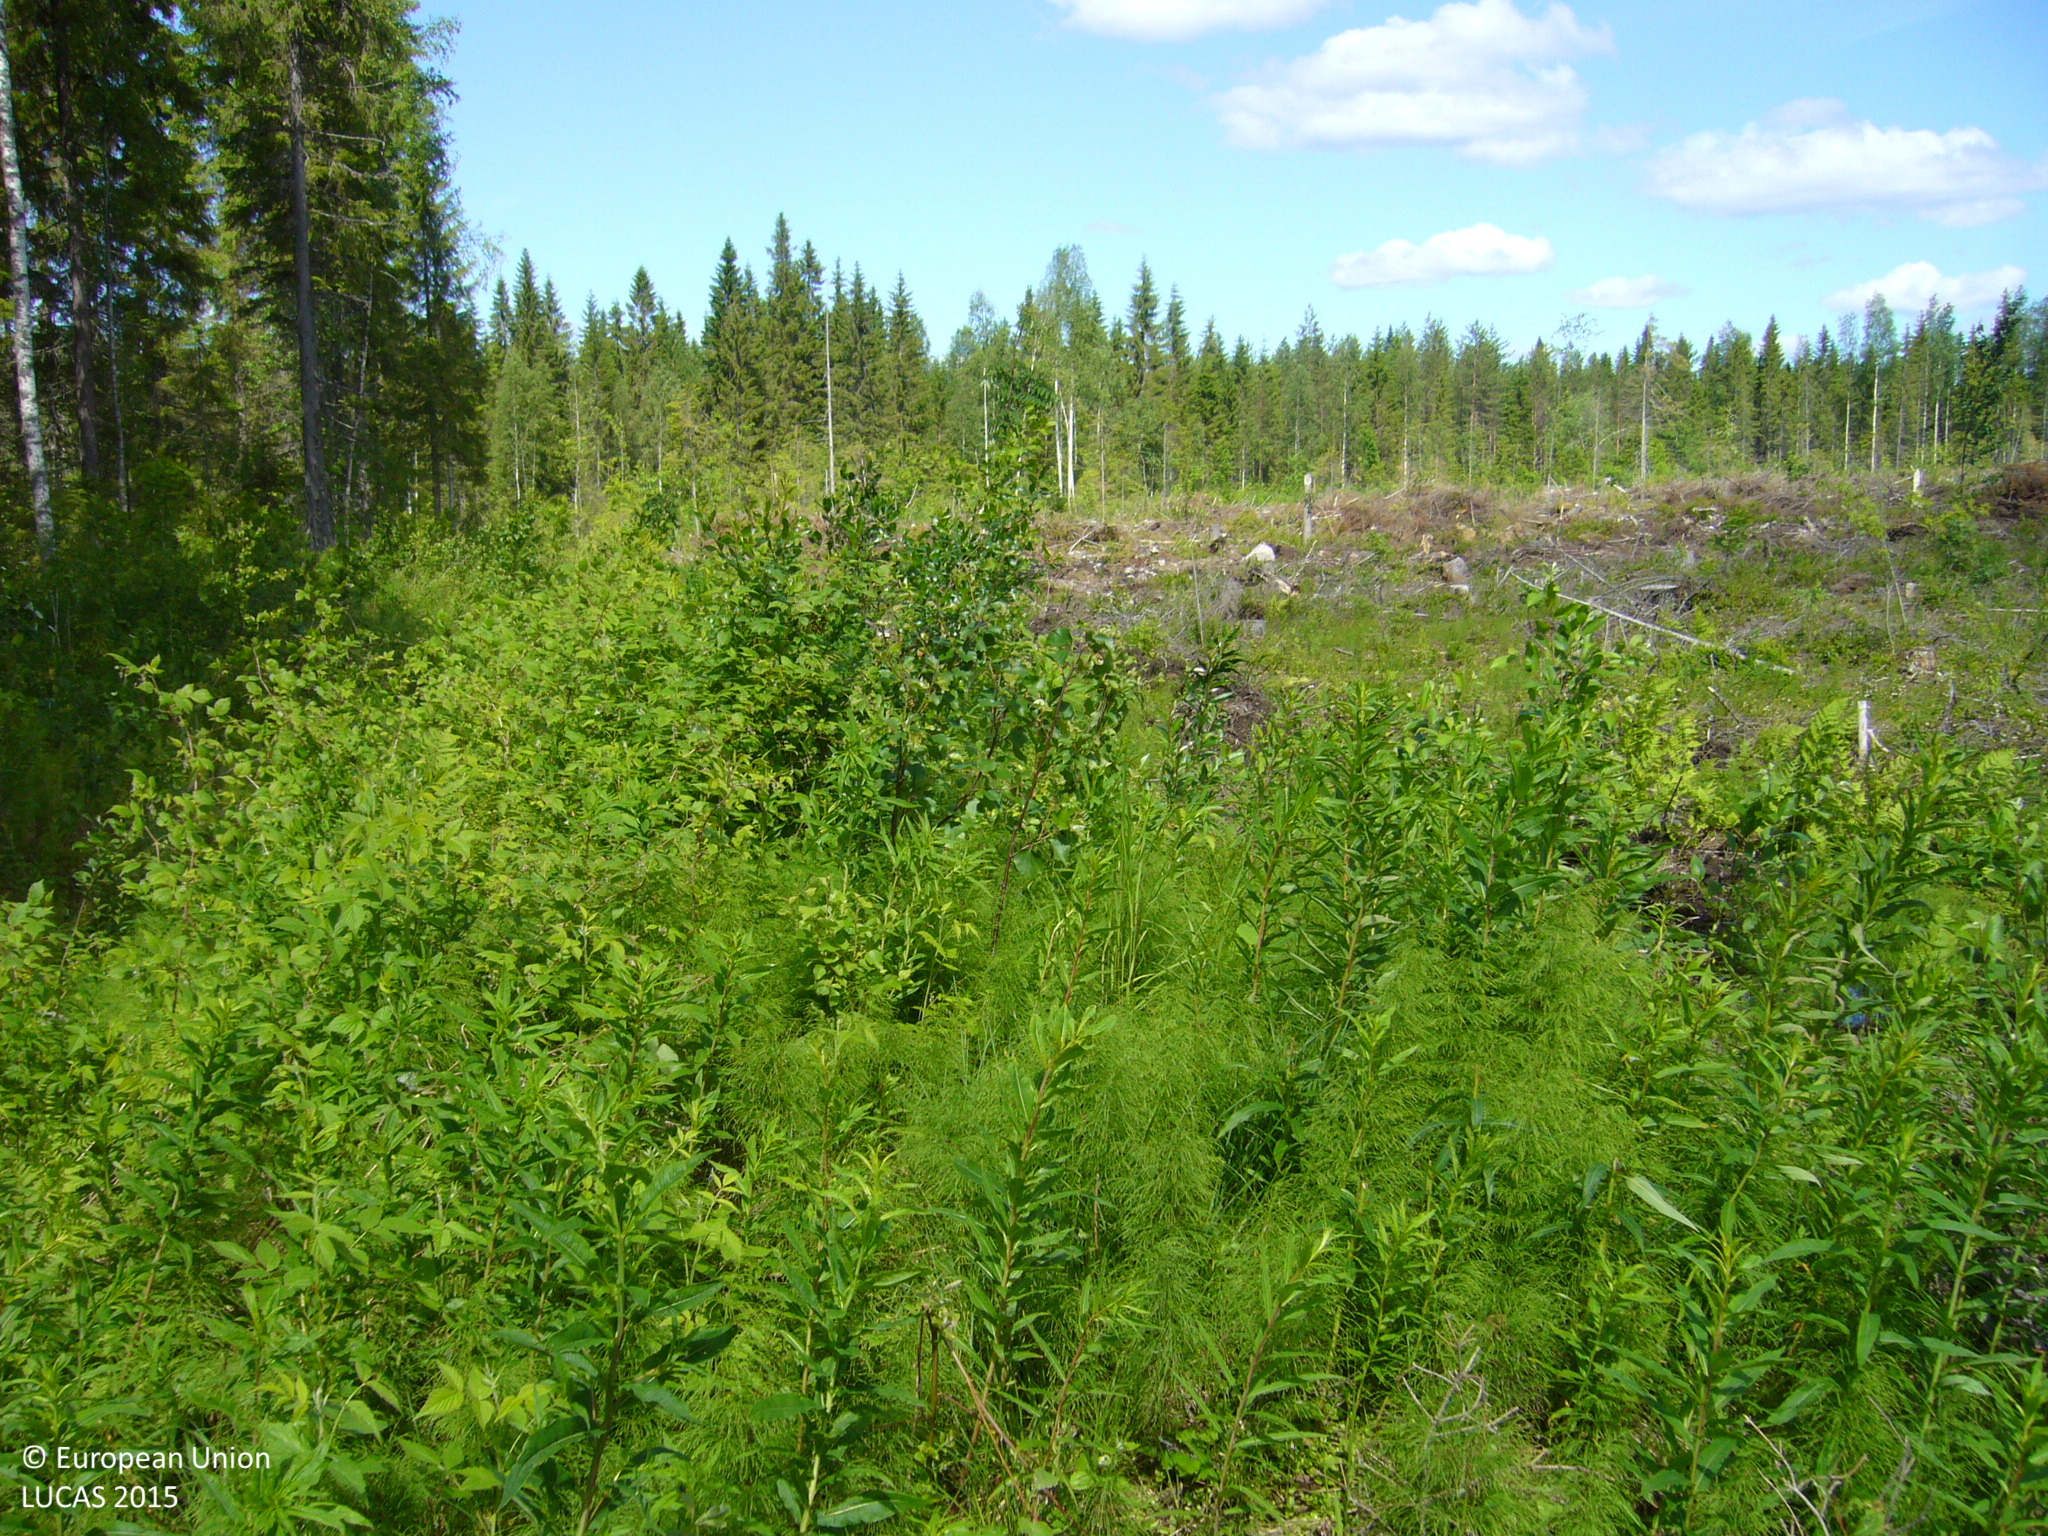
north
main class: Shrubland
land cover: Shrubland without tree cover
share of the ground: 10 - 25 %
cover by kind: herbaceous plants 50 %, shrubs 20 %, consolidated bare surface 10 %, unconsolidated bare surface 10 %
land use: Forestry
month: July
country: FI
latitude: 63.5387
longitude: 26.0247
